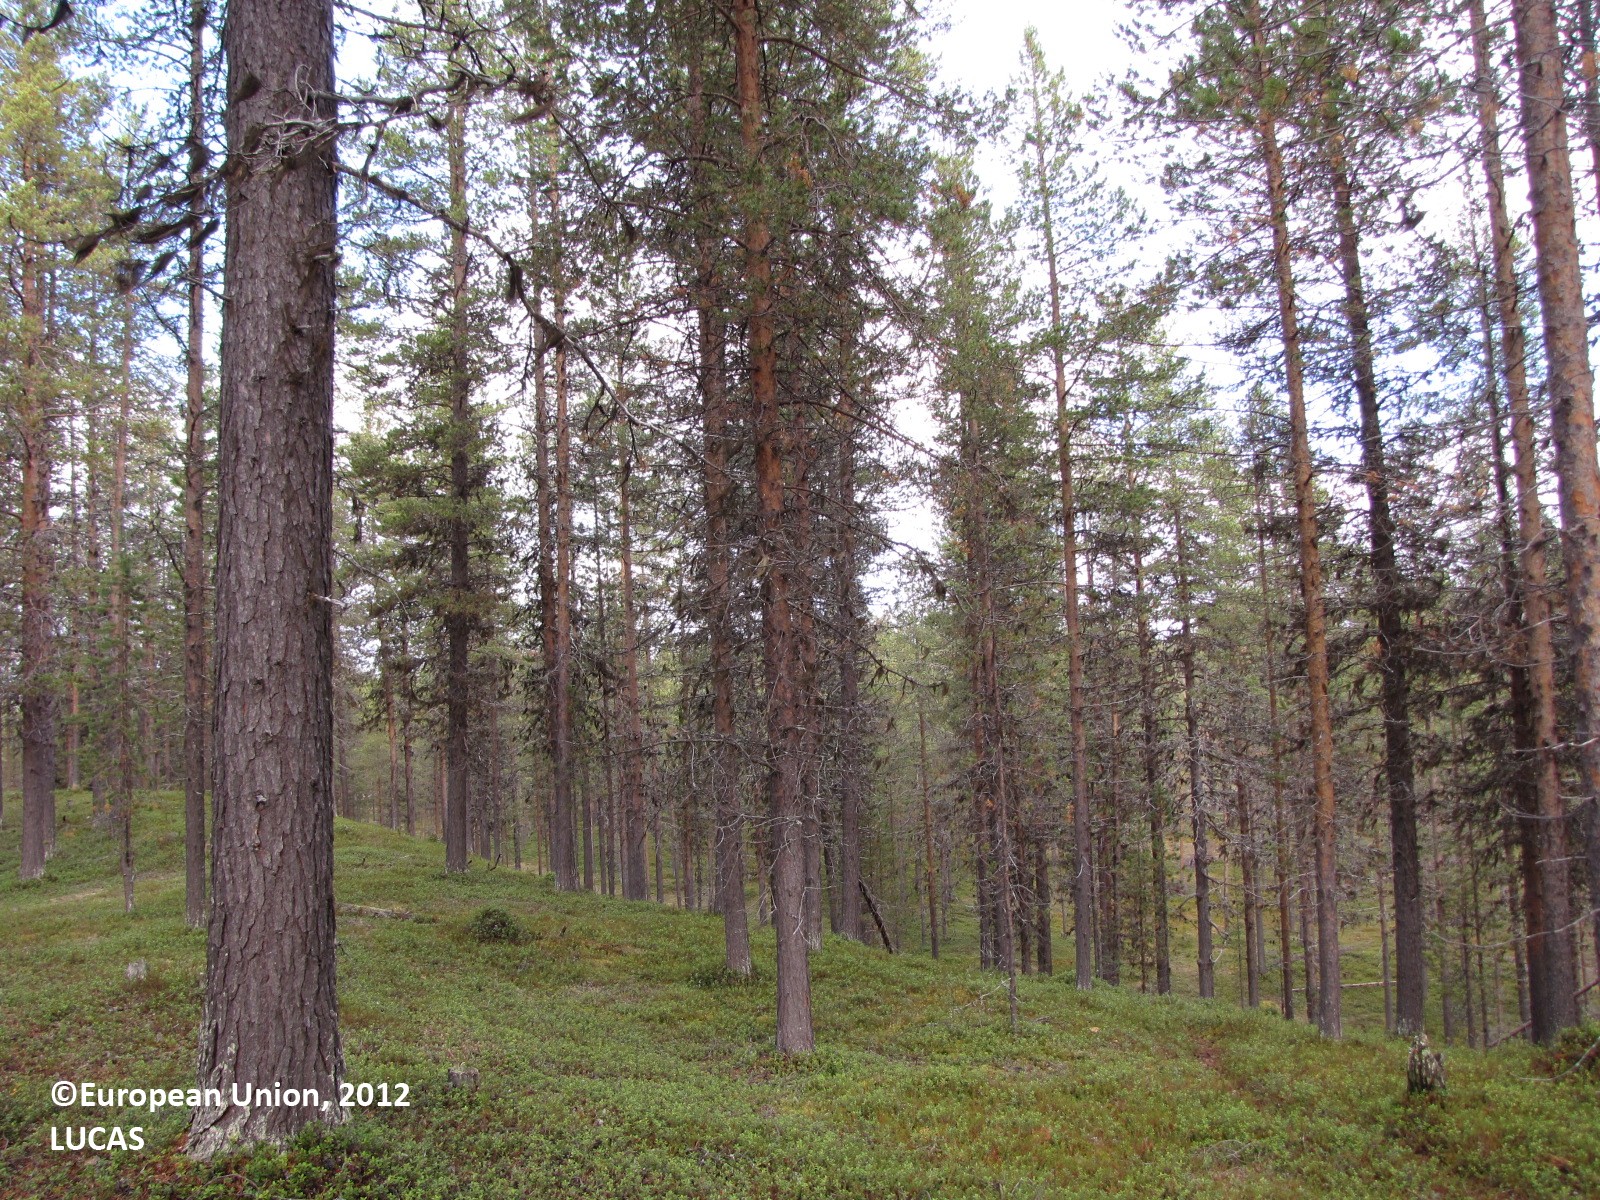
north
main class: Woodland
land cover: Pine dominated coniferous woodland
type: boreal forest
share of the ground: 25 - 50 %
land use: Forestry
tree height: > 5 m
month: September
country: FI
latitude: 67.8669
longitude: 23.5448
